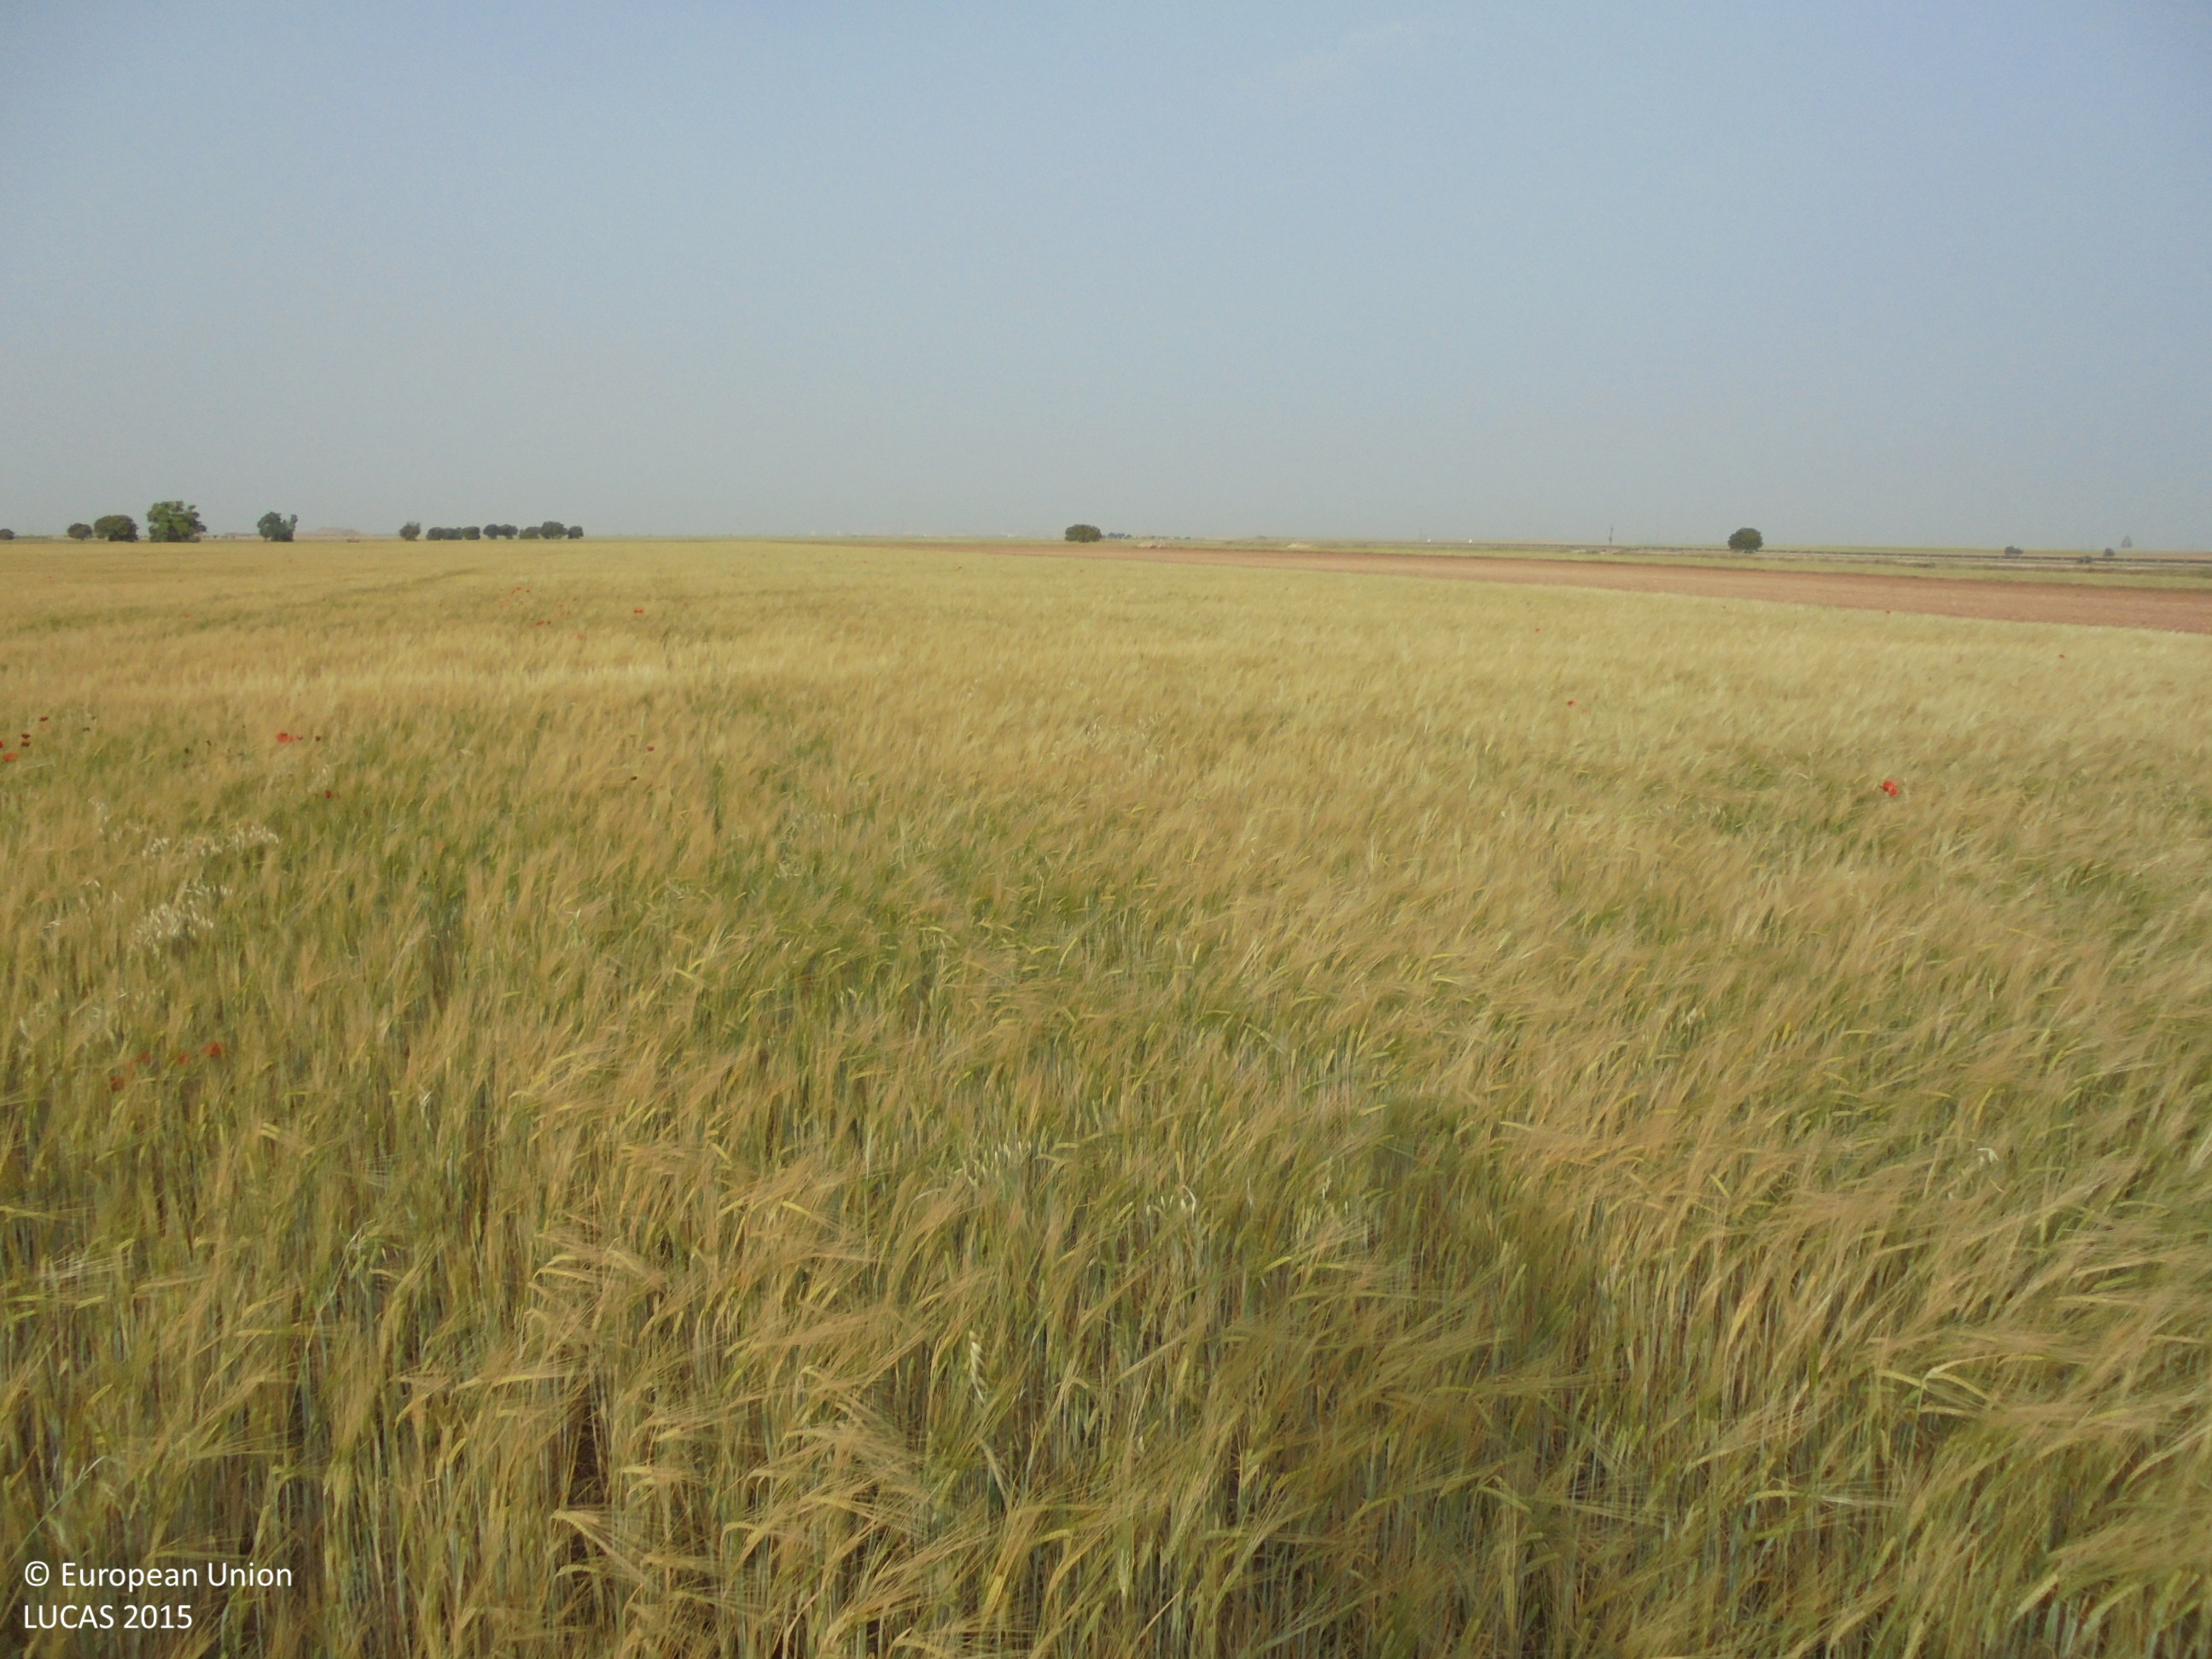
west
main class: Cropland
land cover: Barley
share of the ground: > 75 %
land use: Agriculture (excluding fallow land and kitchen gardens)
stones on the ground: 25 - 50 %
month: May
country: ES
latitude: 39.0318
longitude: -1.7251
